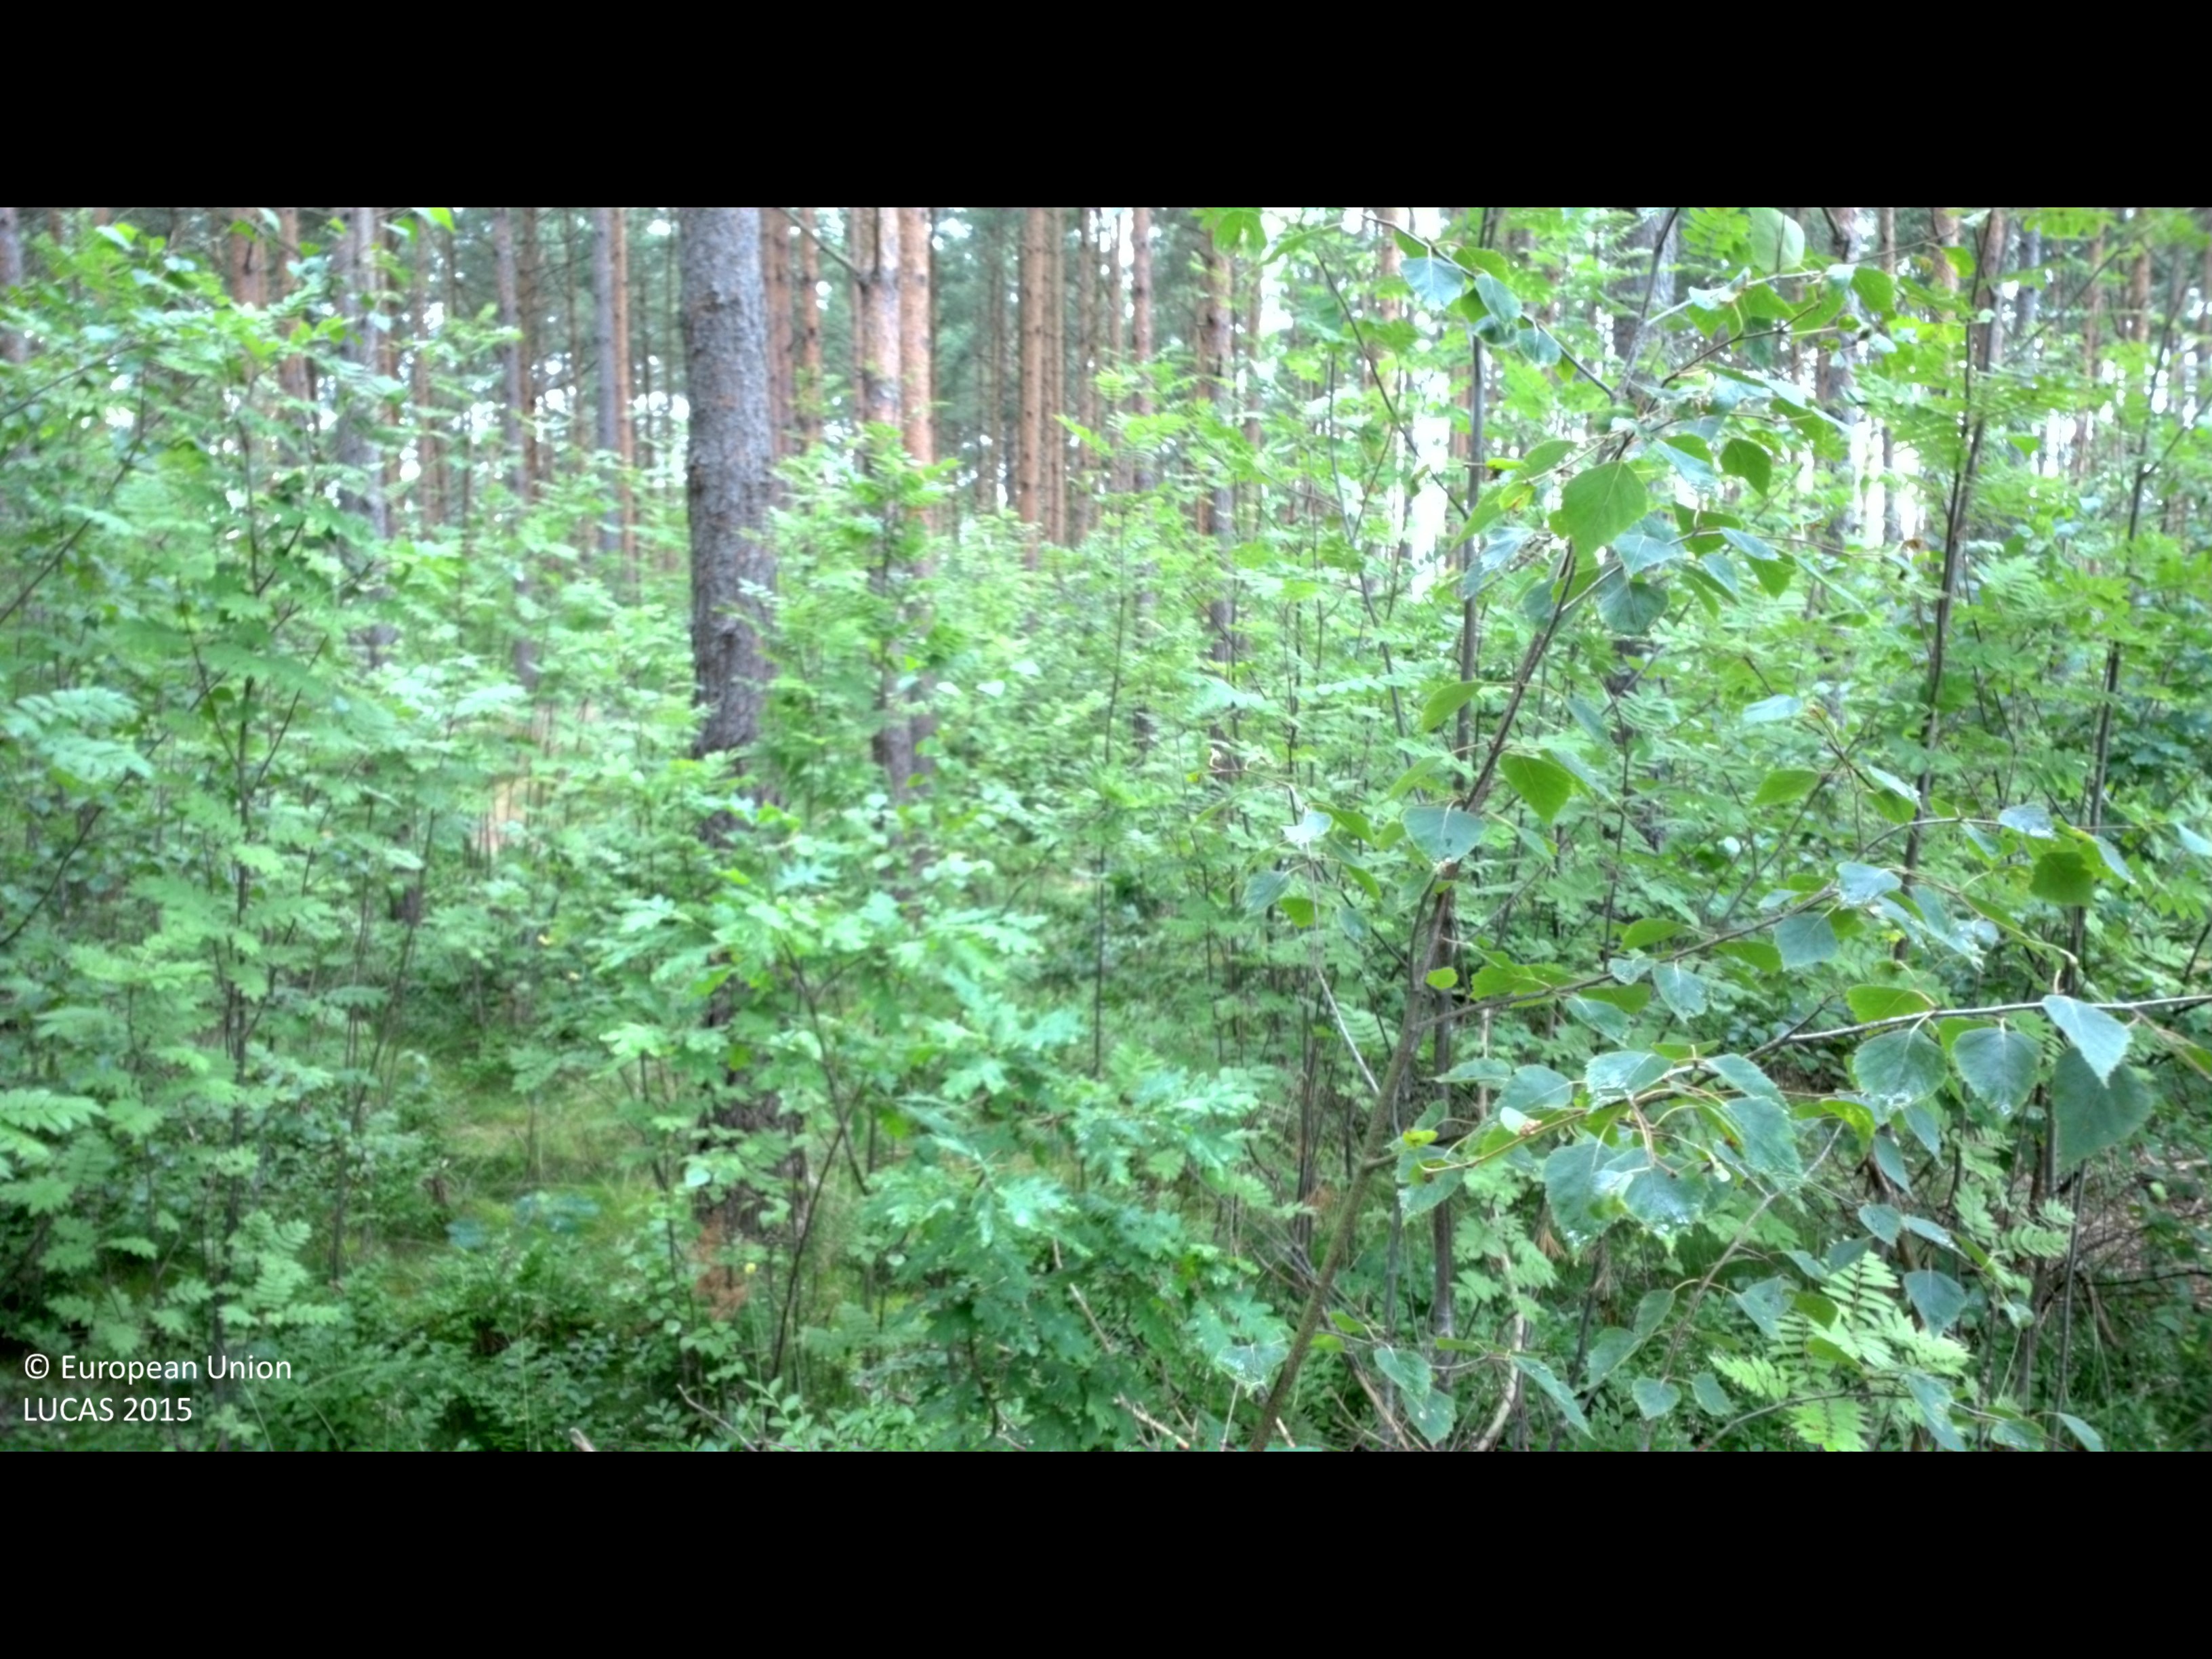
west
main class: Woodland
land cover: Pine dominated coniferous woodland
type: boreal forest
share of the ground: 50 - 75 %
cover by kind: coniferous forest trees 65 %, shrubs 20 %, broadleaved forest trees 10 %, herbaceous plants 5 %
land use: Forestry
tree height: > 5 m
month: July
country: SE
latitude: 57.2579
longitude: 17.0473
